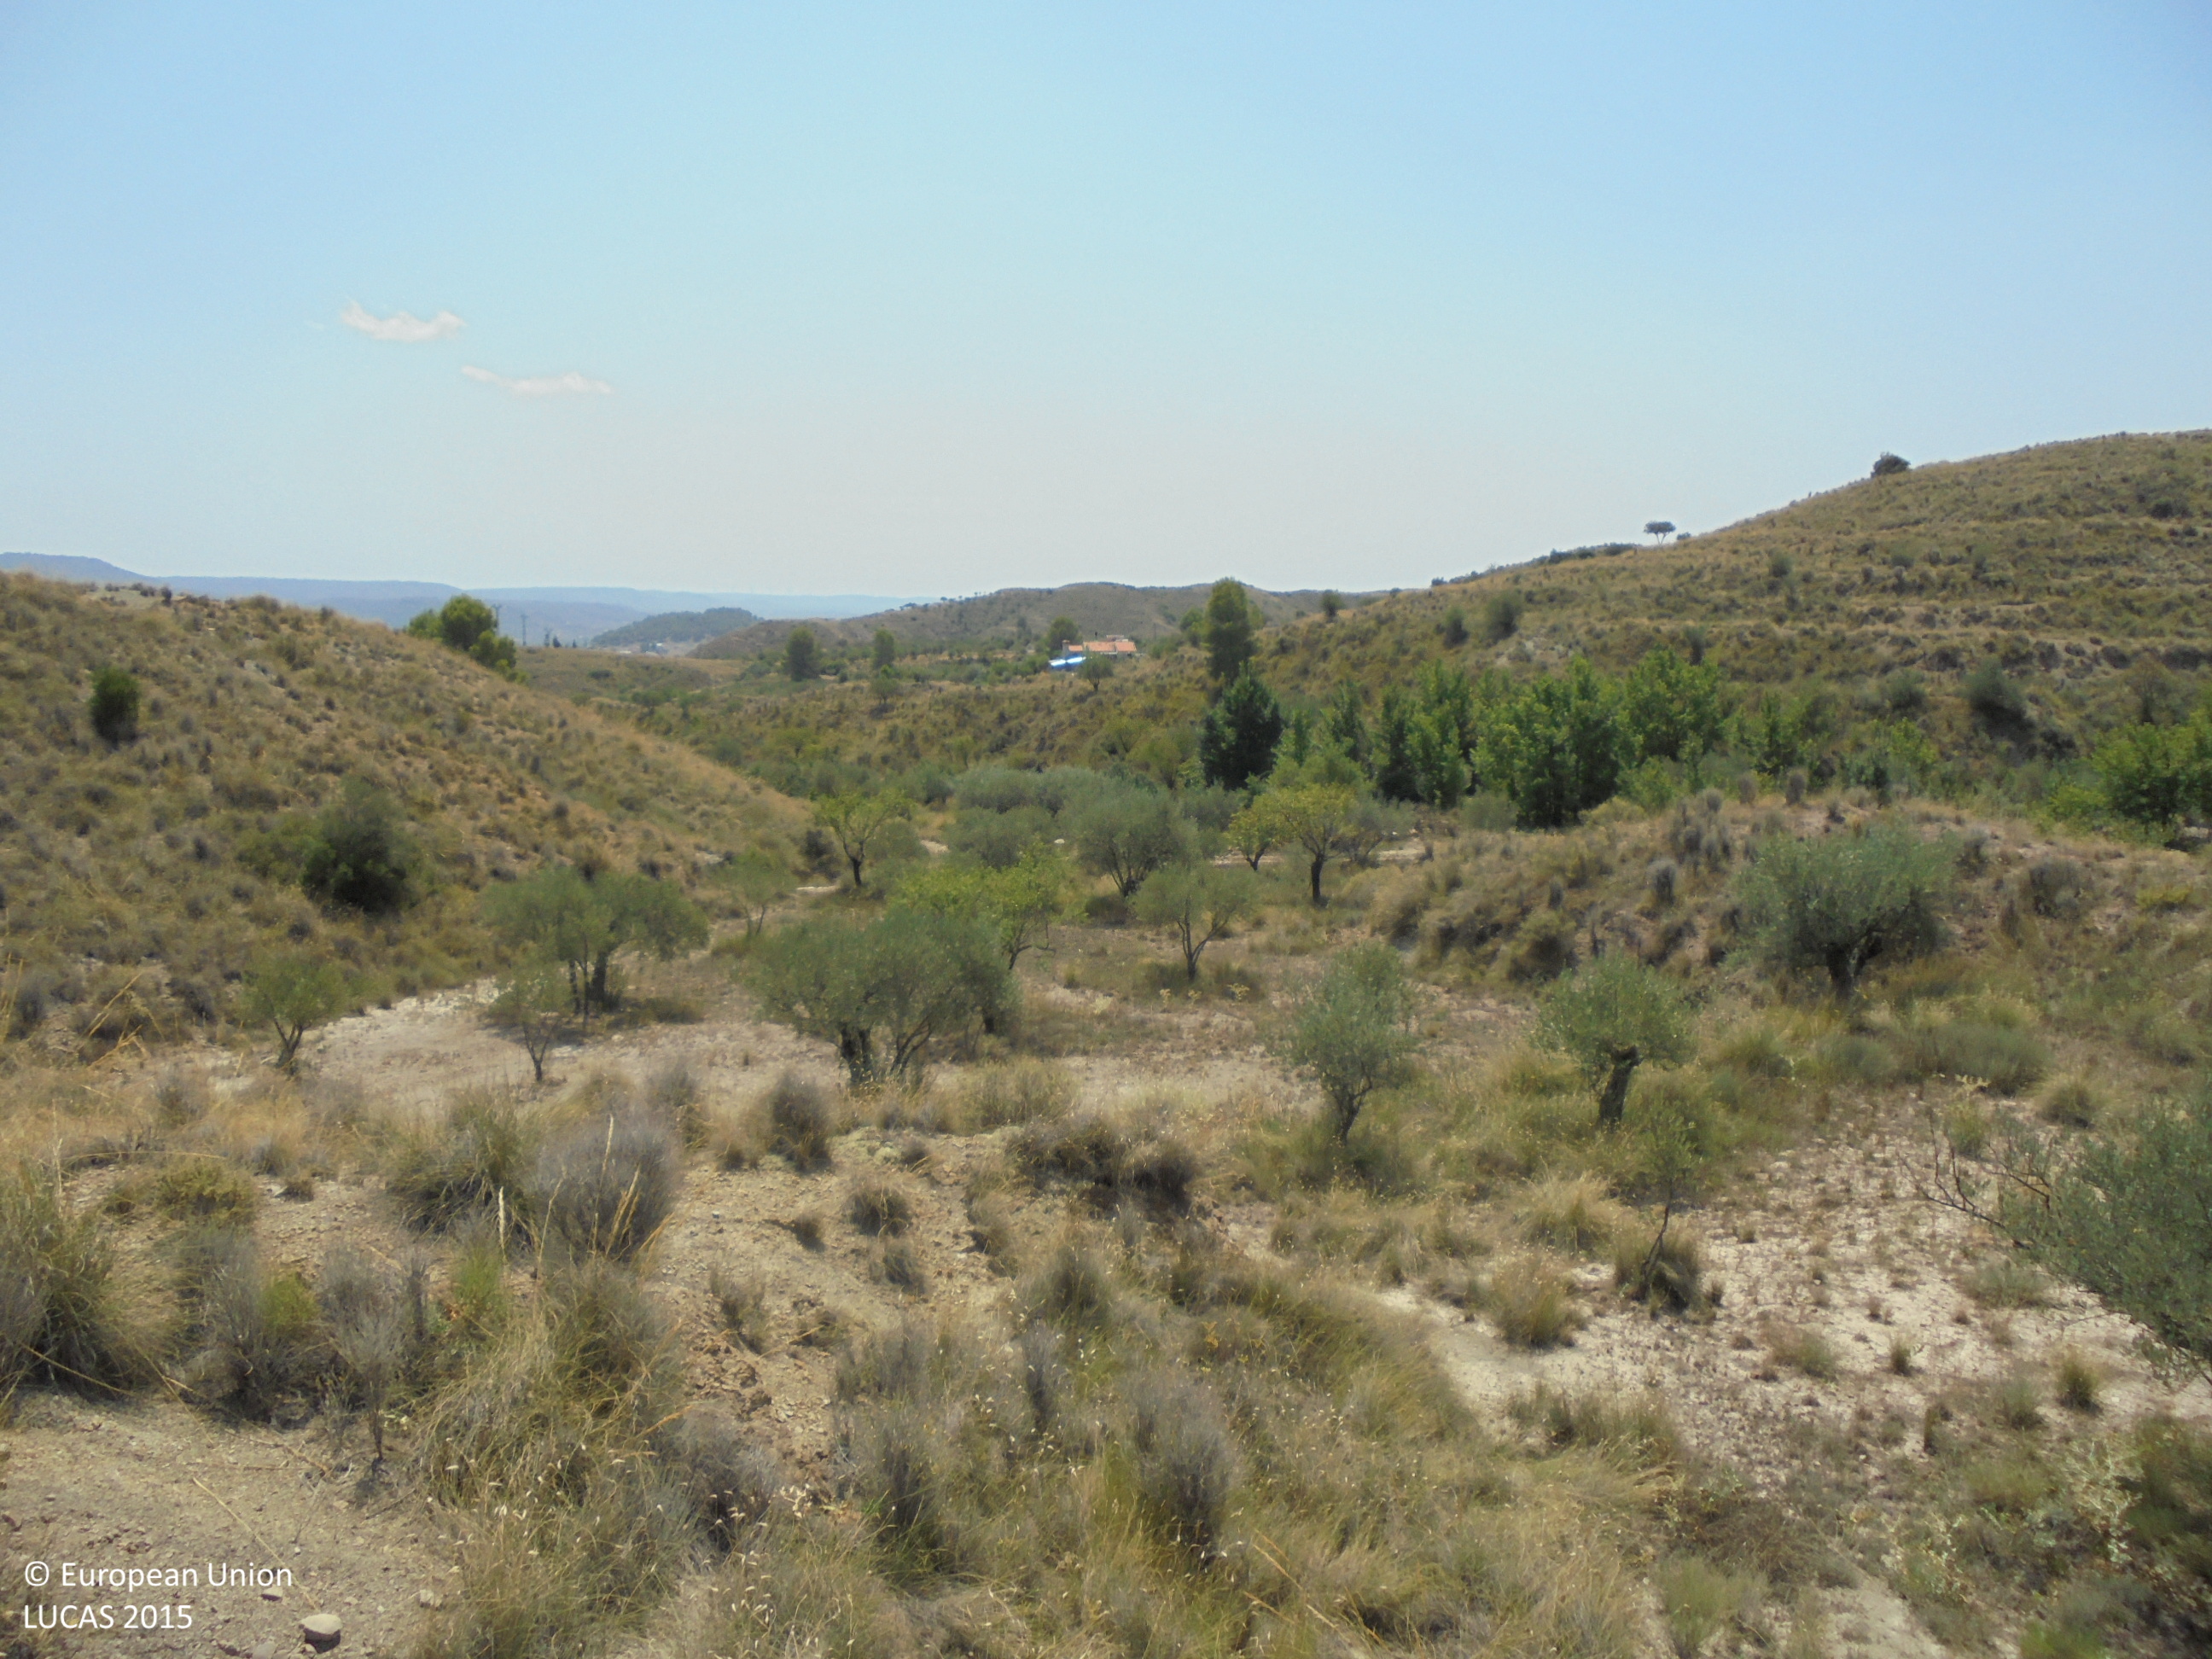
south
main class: Shrubland
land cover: Shrubland without tree cover
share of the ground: 25 - 50 %
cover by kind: unconsolidated bare surface 60 %, shrubs 40 %
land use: Semi-natural and natural areas not in use
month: August
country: ES
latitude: 39.1281
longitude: -1.0672
